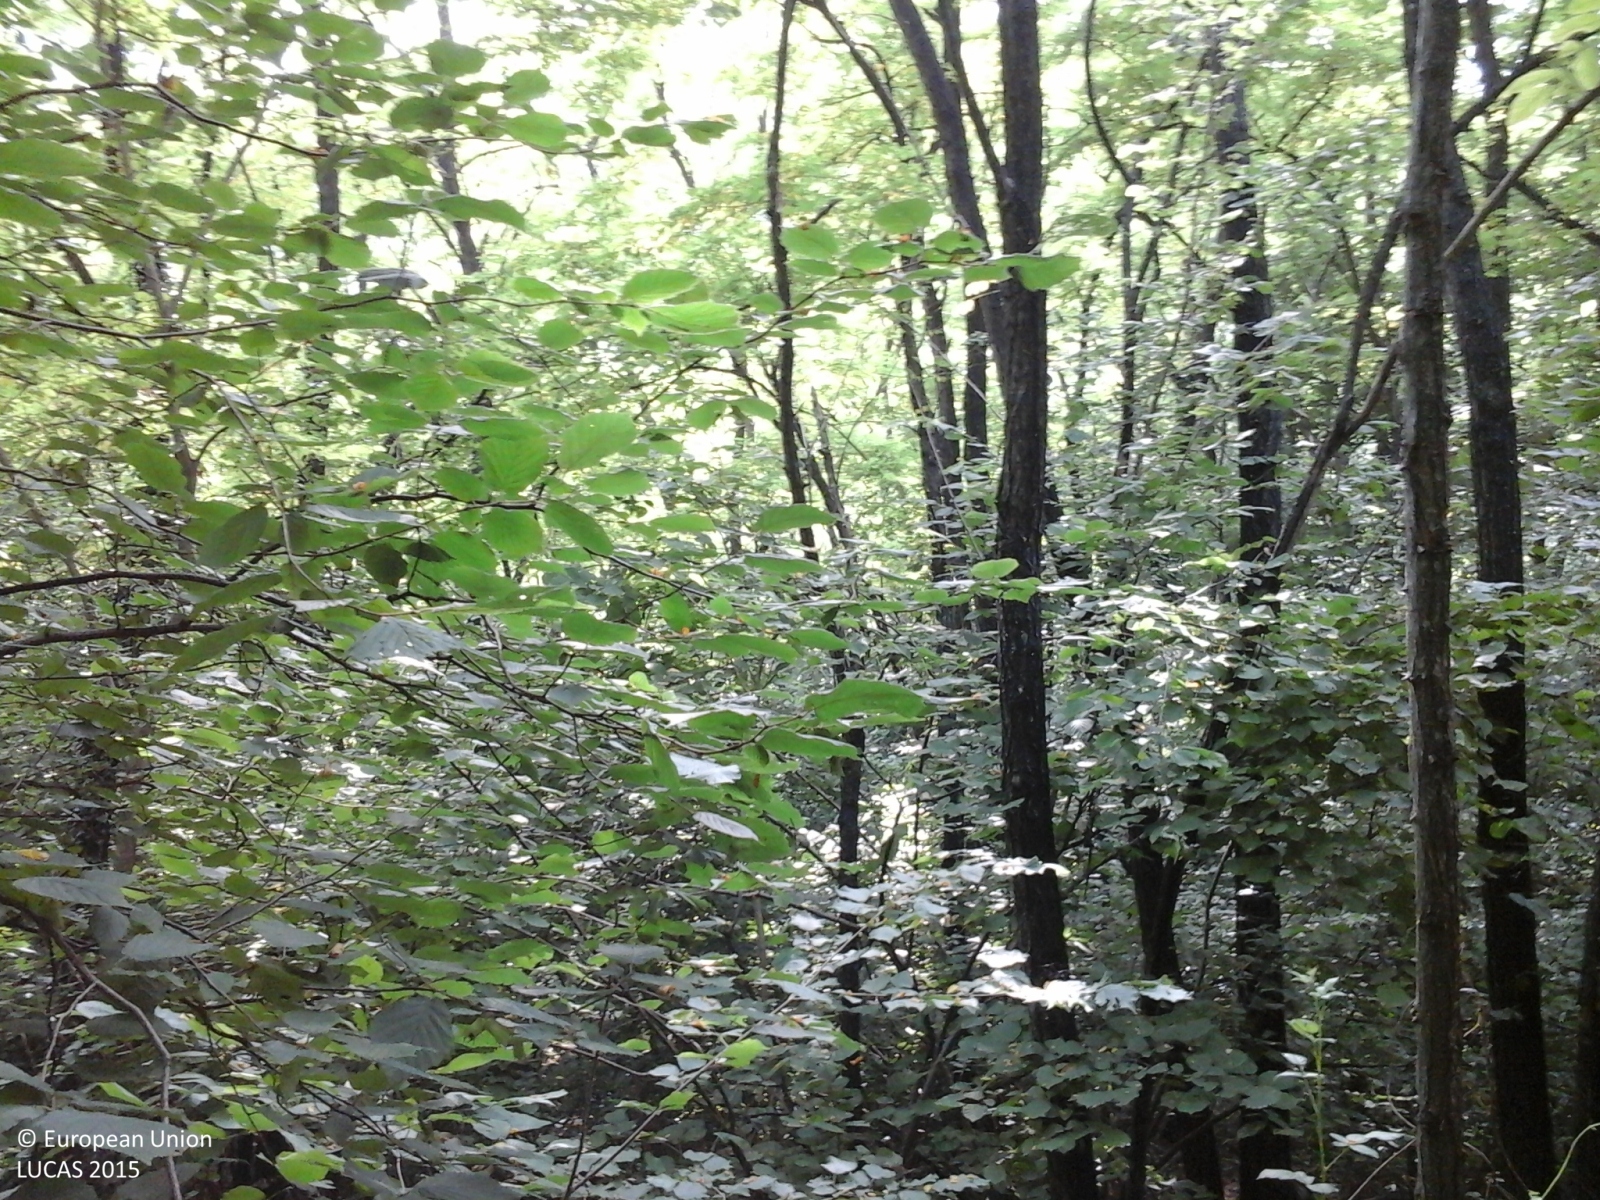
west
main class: Woodland
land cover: Broadleaved woodland
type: thermophilous deciduous forest
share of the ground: > 75 %
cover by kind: broadleaved forest trees 100 %
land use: Semi-natural and natural areas not in use
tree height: > 5 m
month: June
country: IT
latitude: 44.6855
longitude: 8.7283
